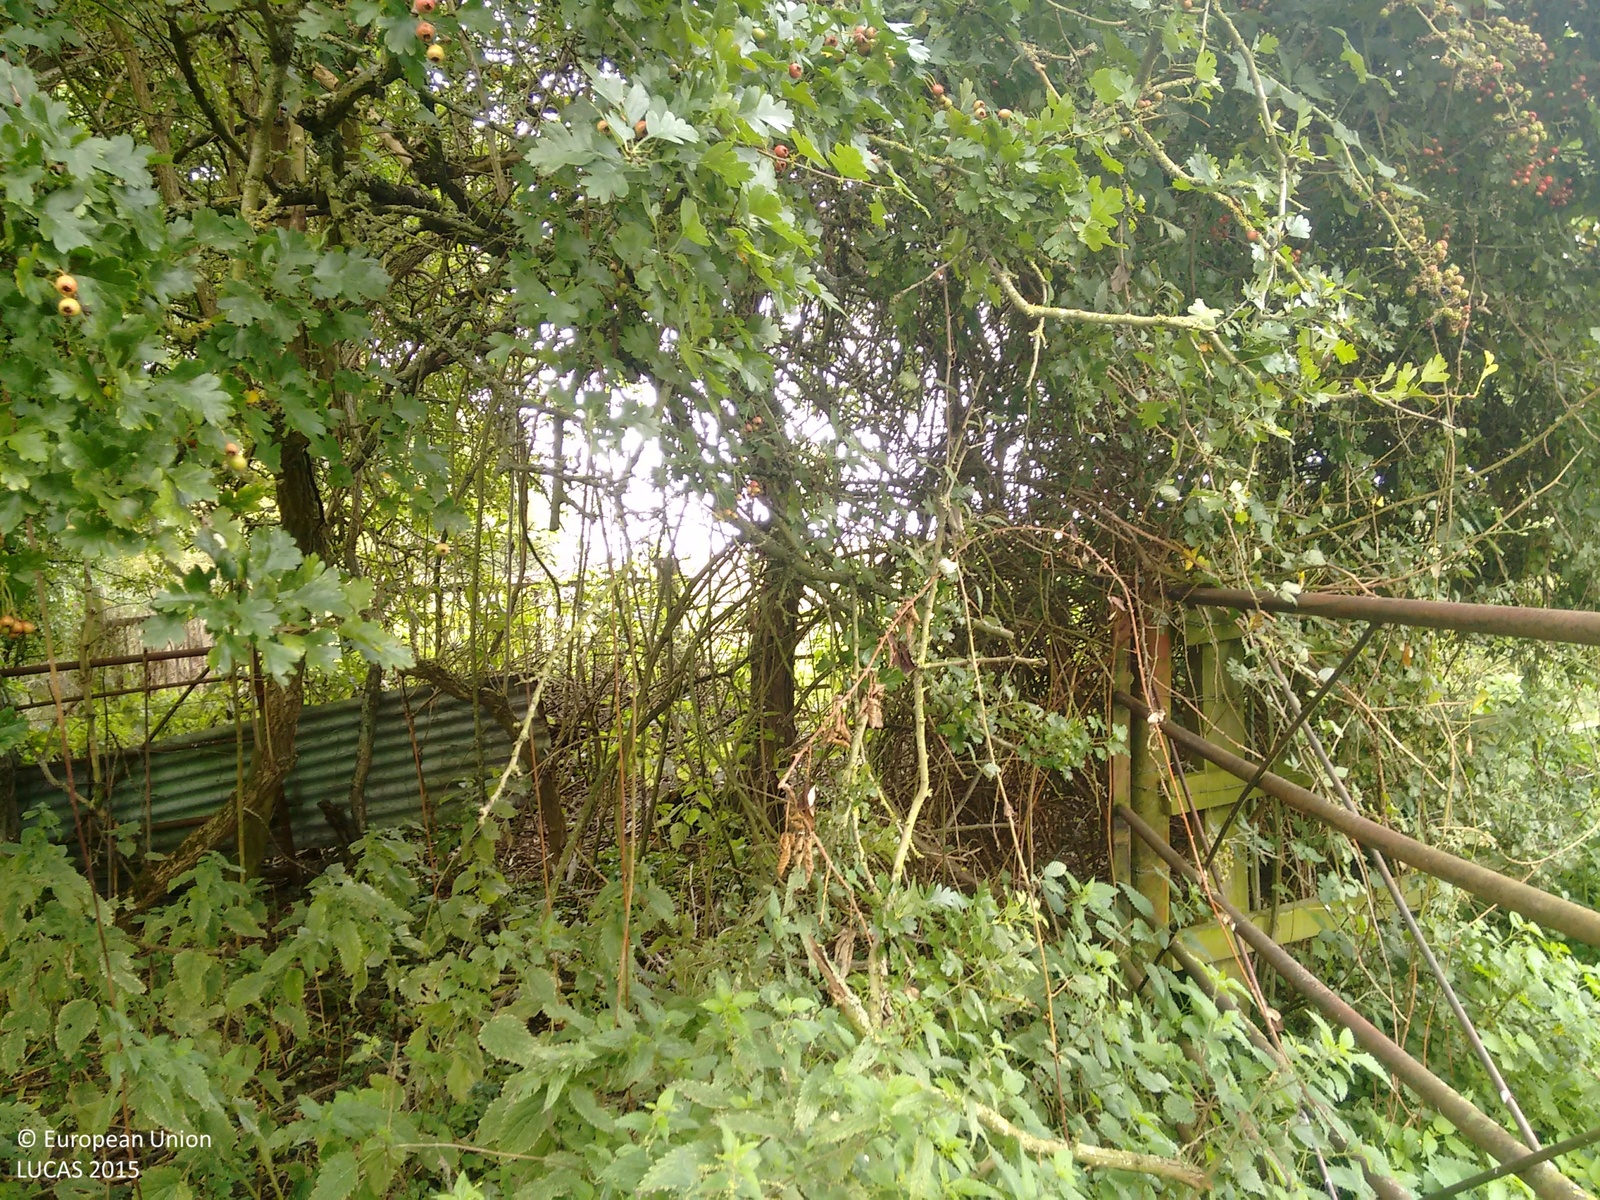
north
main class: Grassland
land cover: Grassland without tree/shrub cover
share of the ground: > 75 %
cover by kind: herbaceous plants 100 %
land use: Agriculture (excluding fallow land and kitchen gardens)
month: September
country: GB
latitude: 52.2297
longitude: 0.9428
